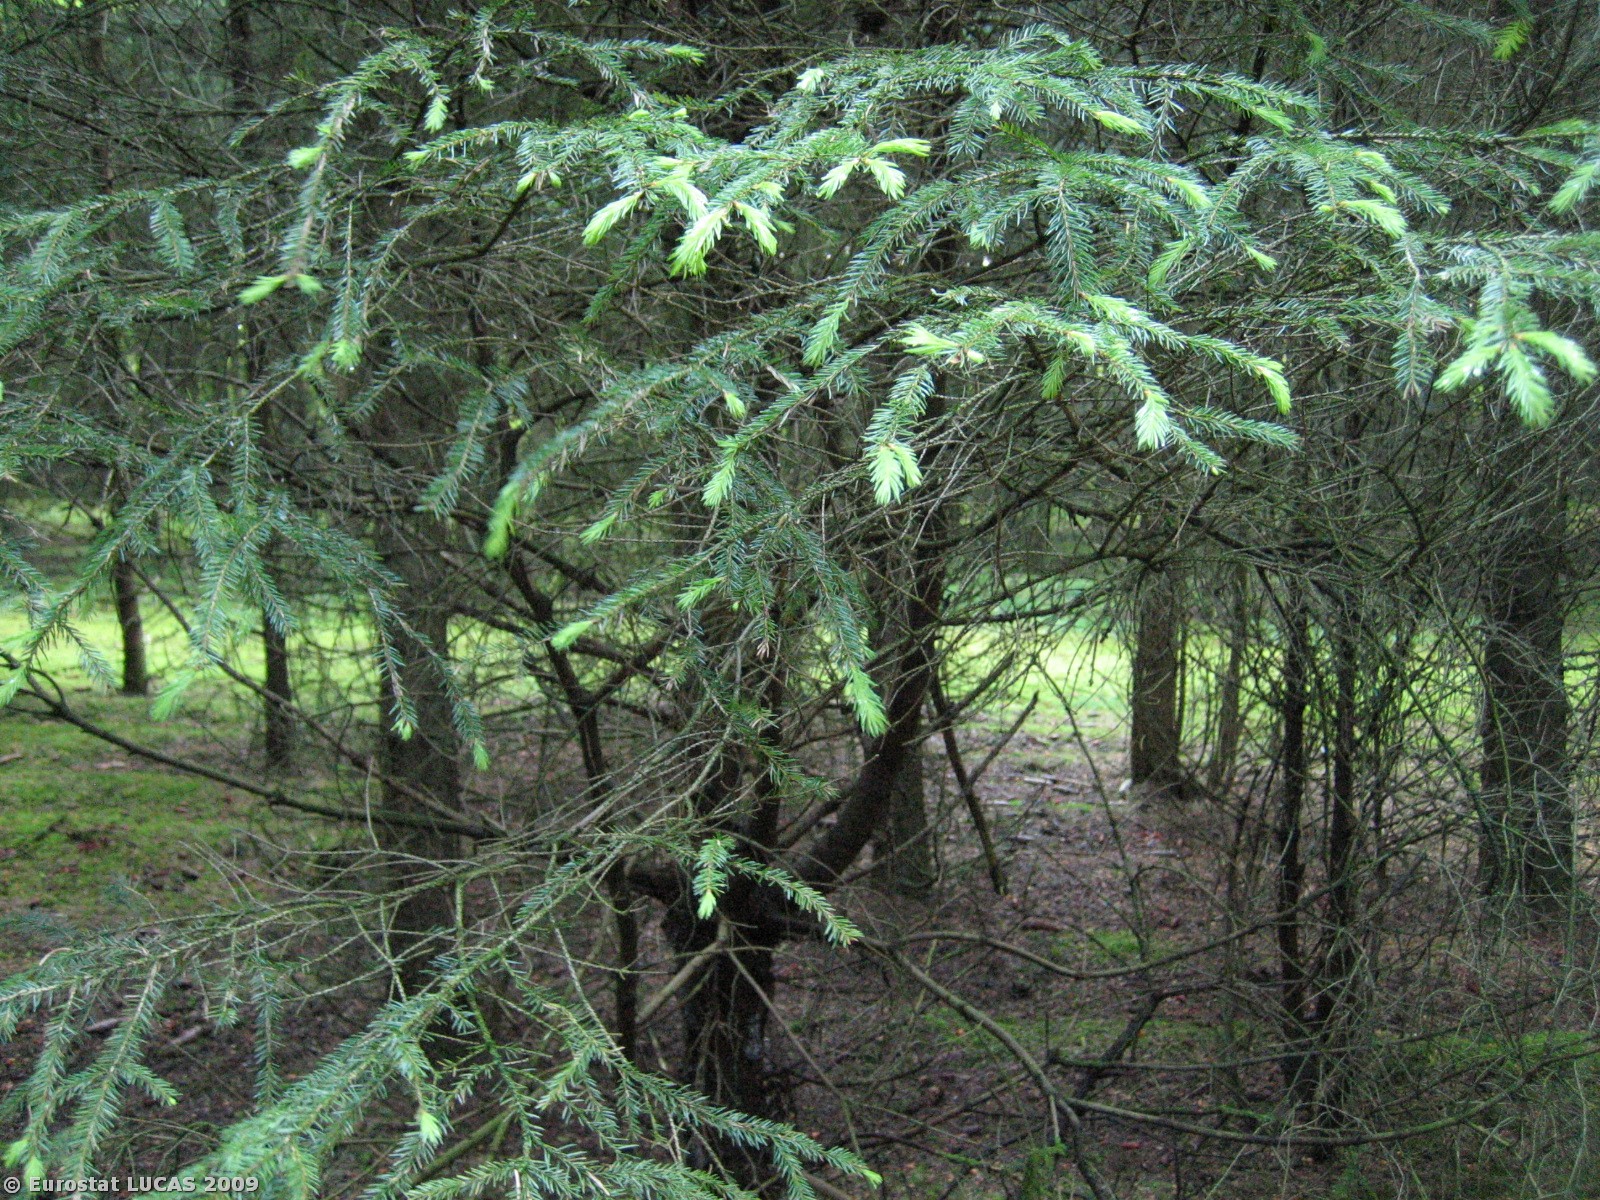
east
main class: Woodland
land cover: Coniferous woodland
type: hemiboreal forest and nemoral coniferous forest and mixed broadleaved-coniferous forest
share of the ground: > 75 %
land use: Forestry
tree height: > 5 m
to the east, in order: Coniferous woodland; Tracks; Broadleaved woodland; Fences; Grassland without tree/shrub cover; Fences; Grassland with sparse tree/shrub cover
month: May
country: DK
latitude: 55.8623
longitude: 9.3137
